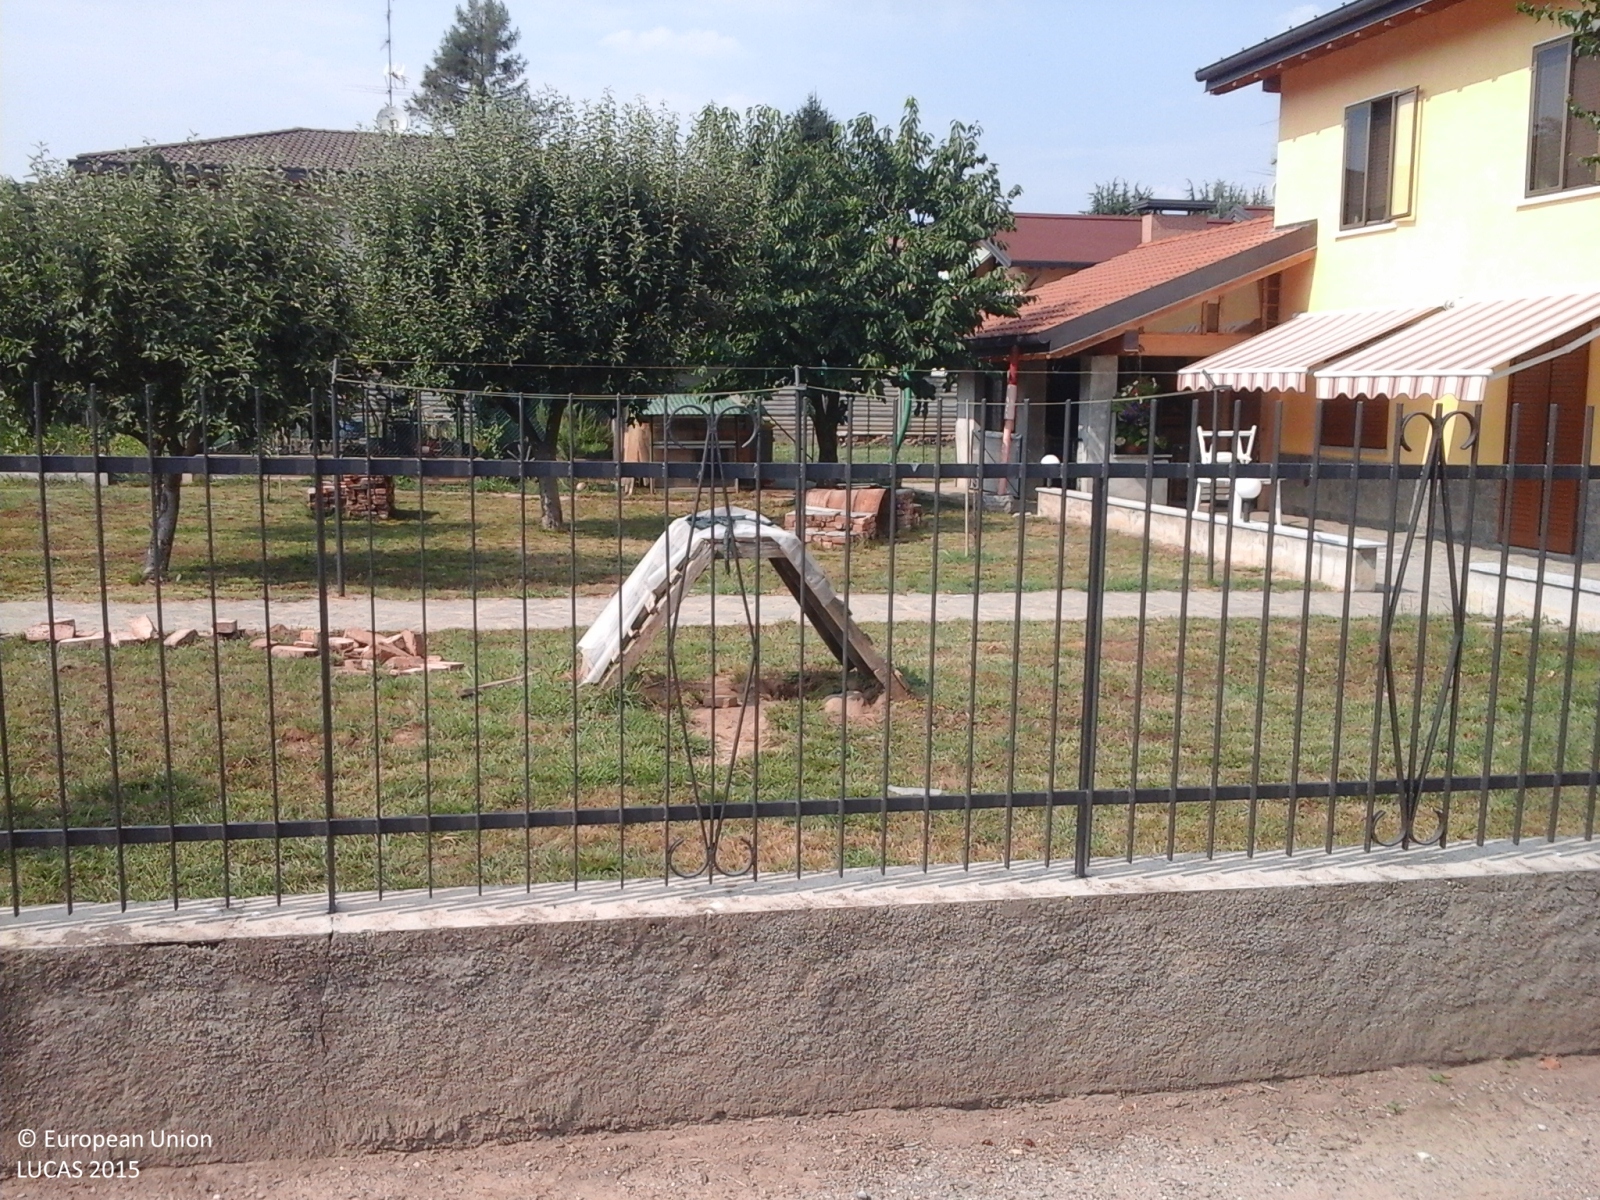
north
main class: Cropland
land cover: Apple fruit
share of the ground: > 75 %
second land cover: Grassland without tree/shrub cover
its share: > 75 %
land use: Kitchen garden
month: July
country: IT
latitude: 45.7319
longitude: 8.8068
